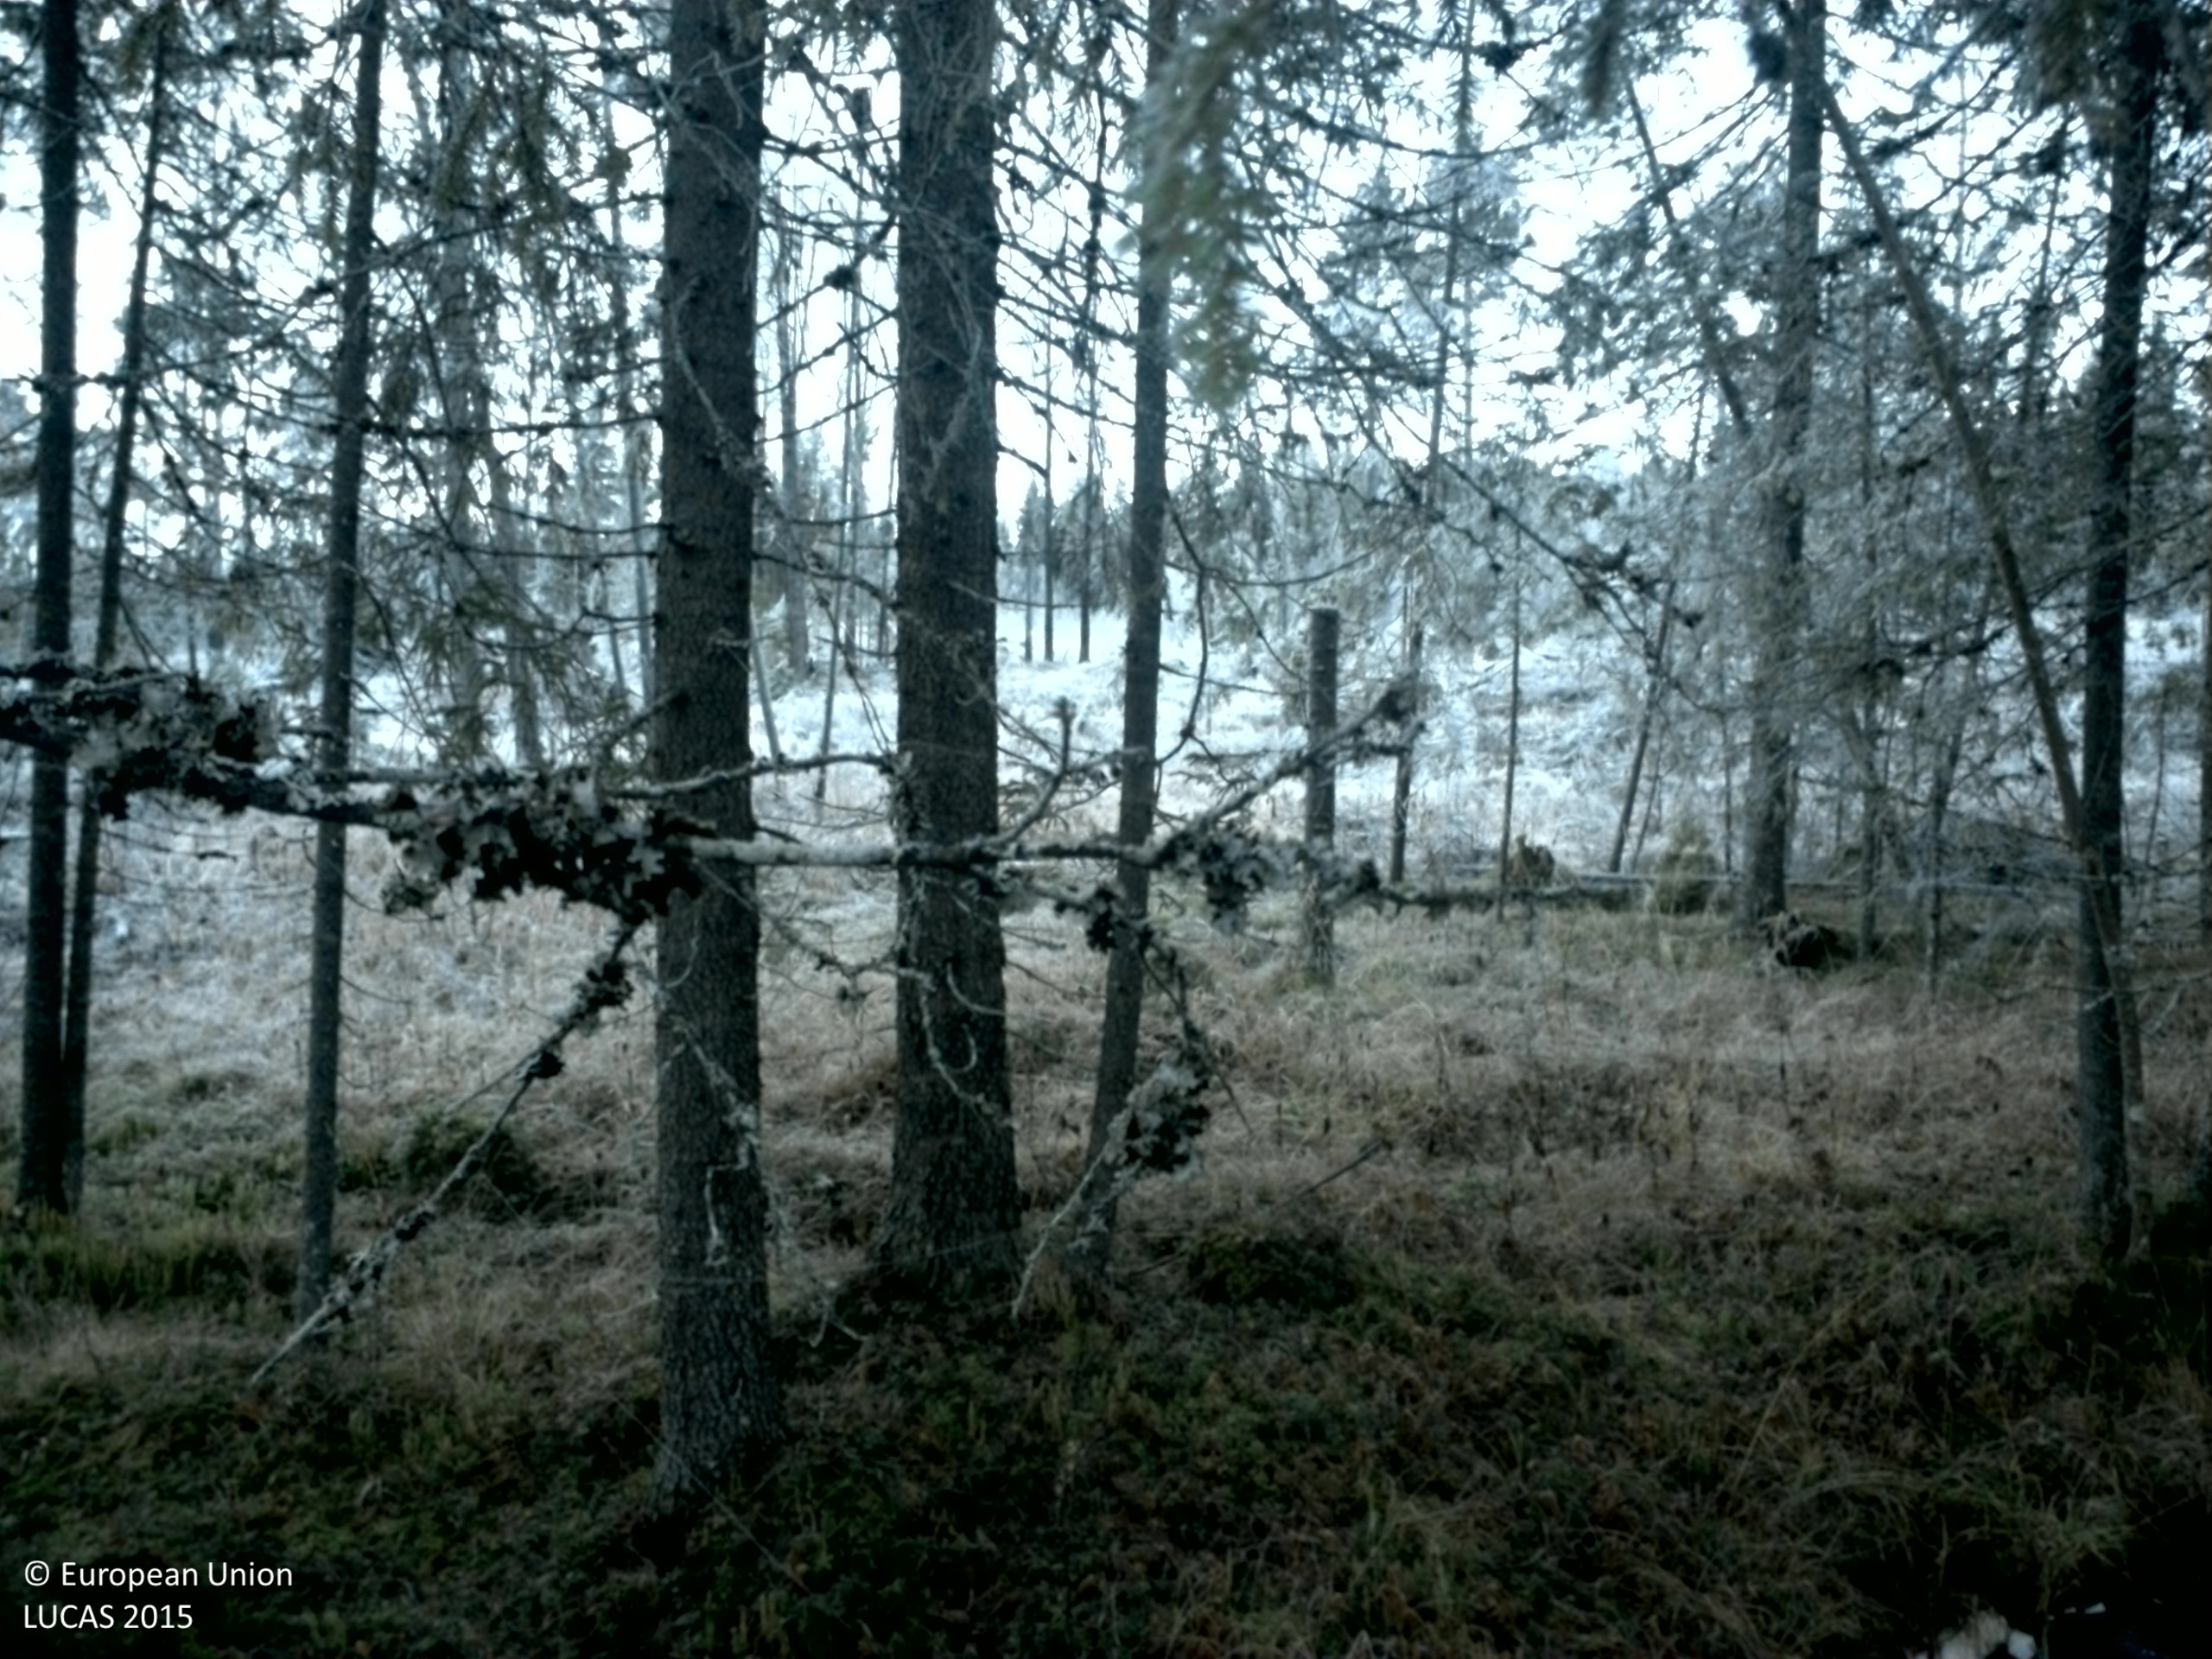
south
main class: Woodland
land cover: Spruce dominated coniferous woodland
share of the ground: 25 - 50 %
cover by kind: herbaceous plants 35 %, coniferous forest trees 20 %, lichens and mosses 20 %, shrubs 15 %, broadleaved forest trees 5 %
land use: Forestry
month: November
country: SE
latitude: 63.7823
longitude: 15.8769
